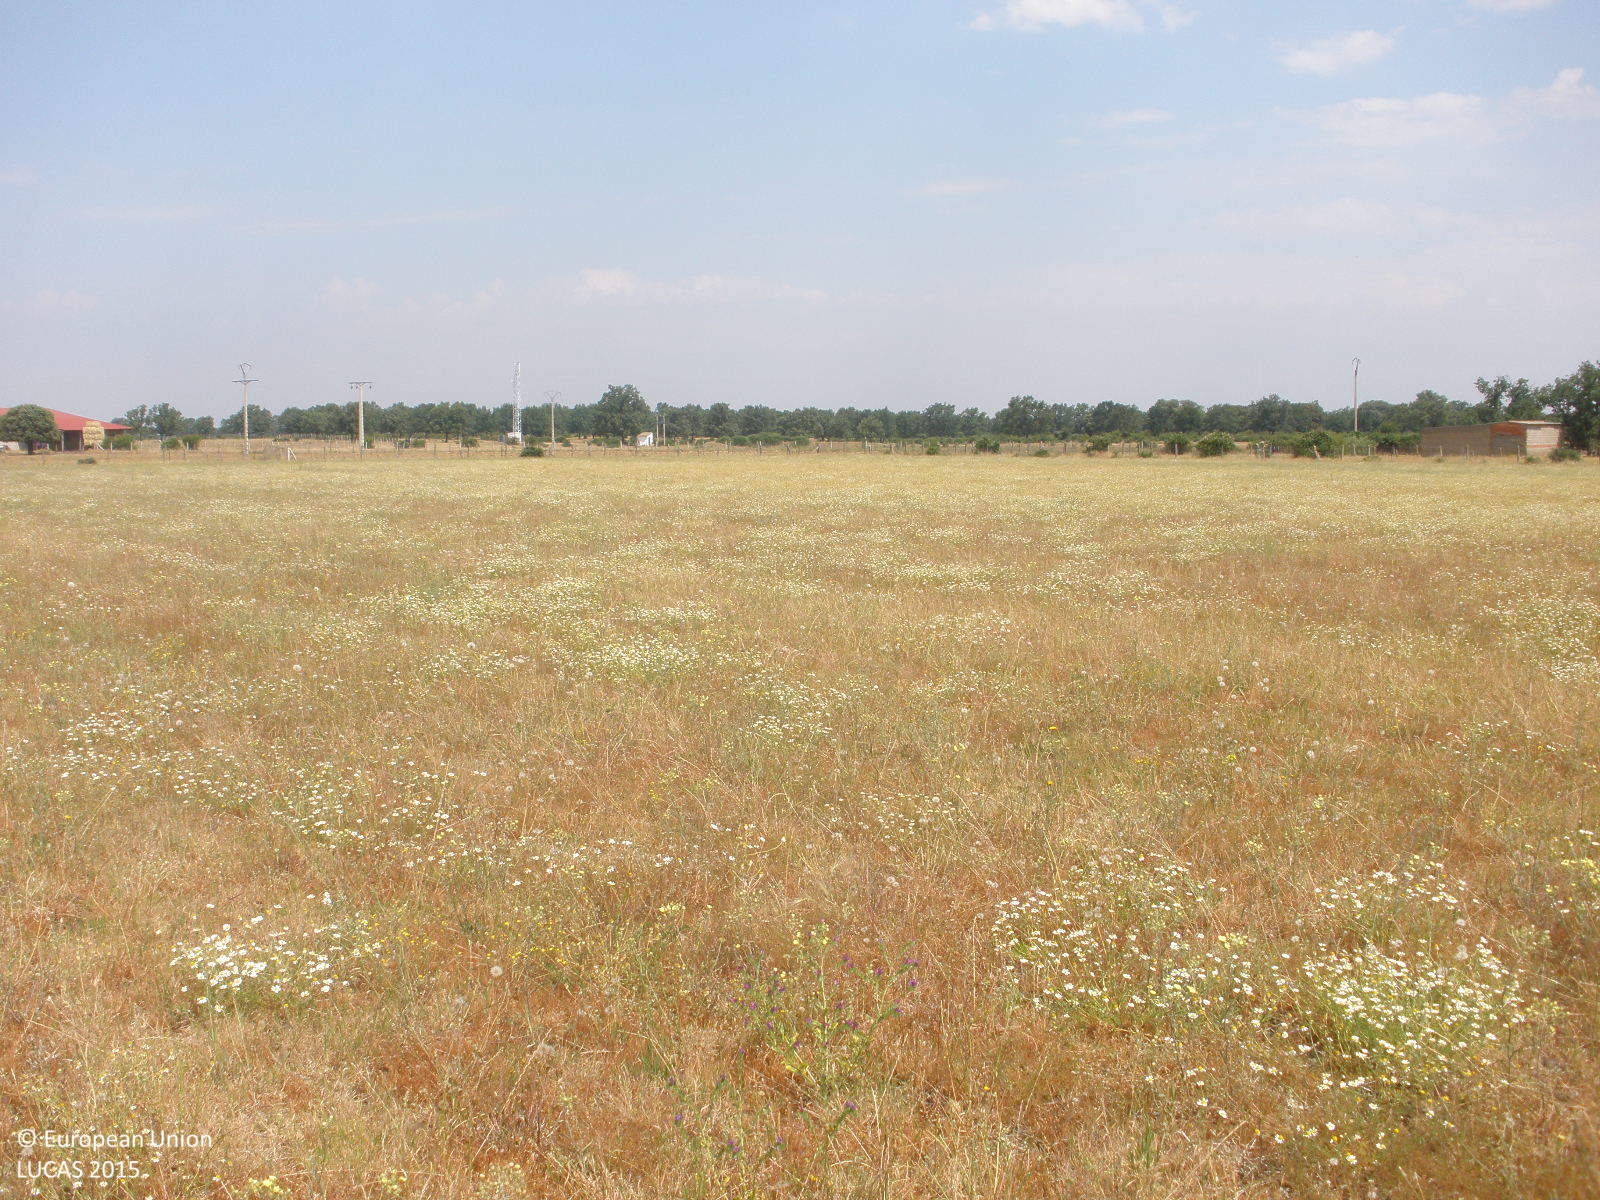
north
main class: Grassland
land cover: Grassland without tree/shrub cover
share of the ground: > 75 %
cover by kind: herbaceous plants 100 %
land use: Agriculture (excluding fallow land and kitchen gardens)
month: June
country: ES
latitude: 40.6392
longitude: -6.3205
